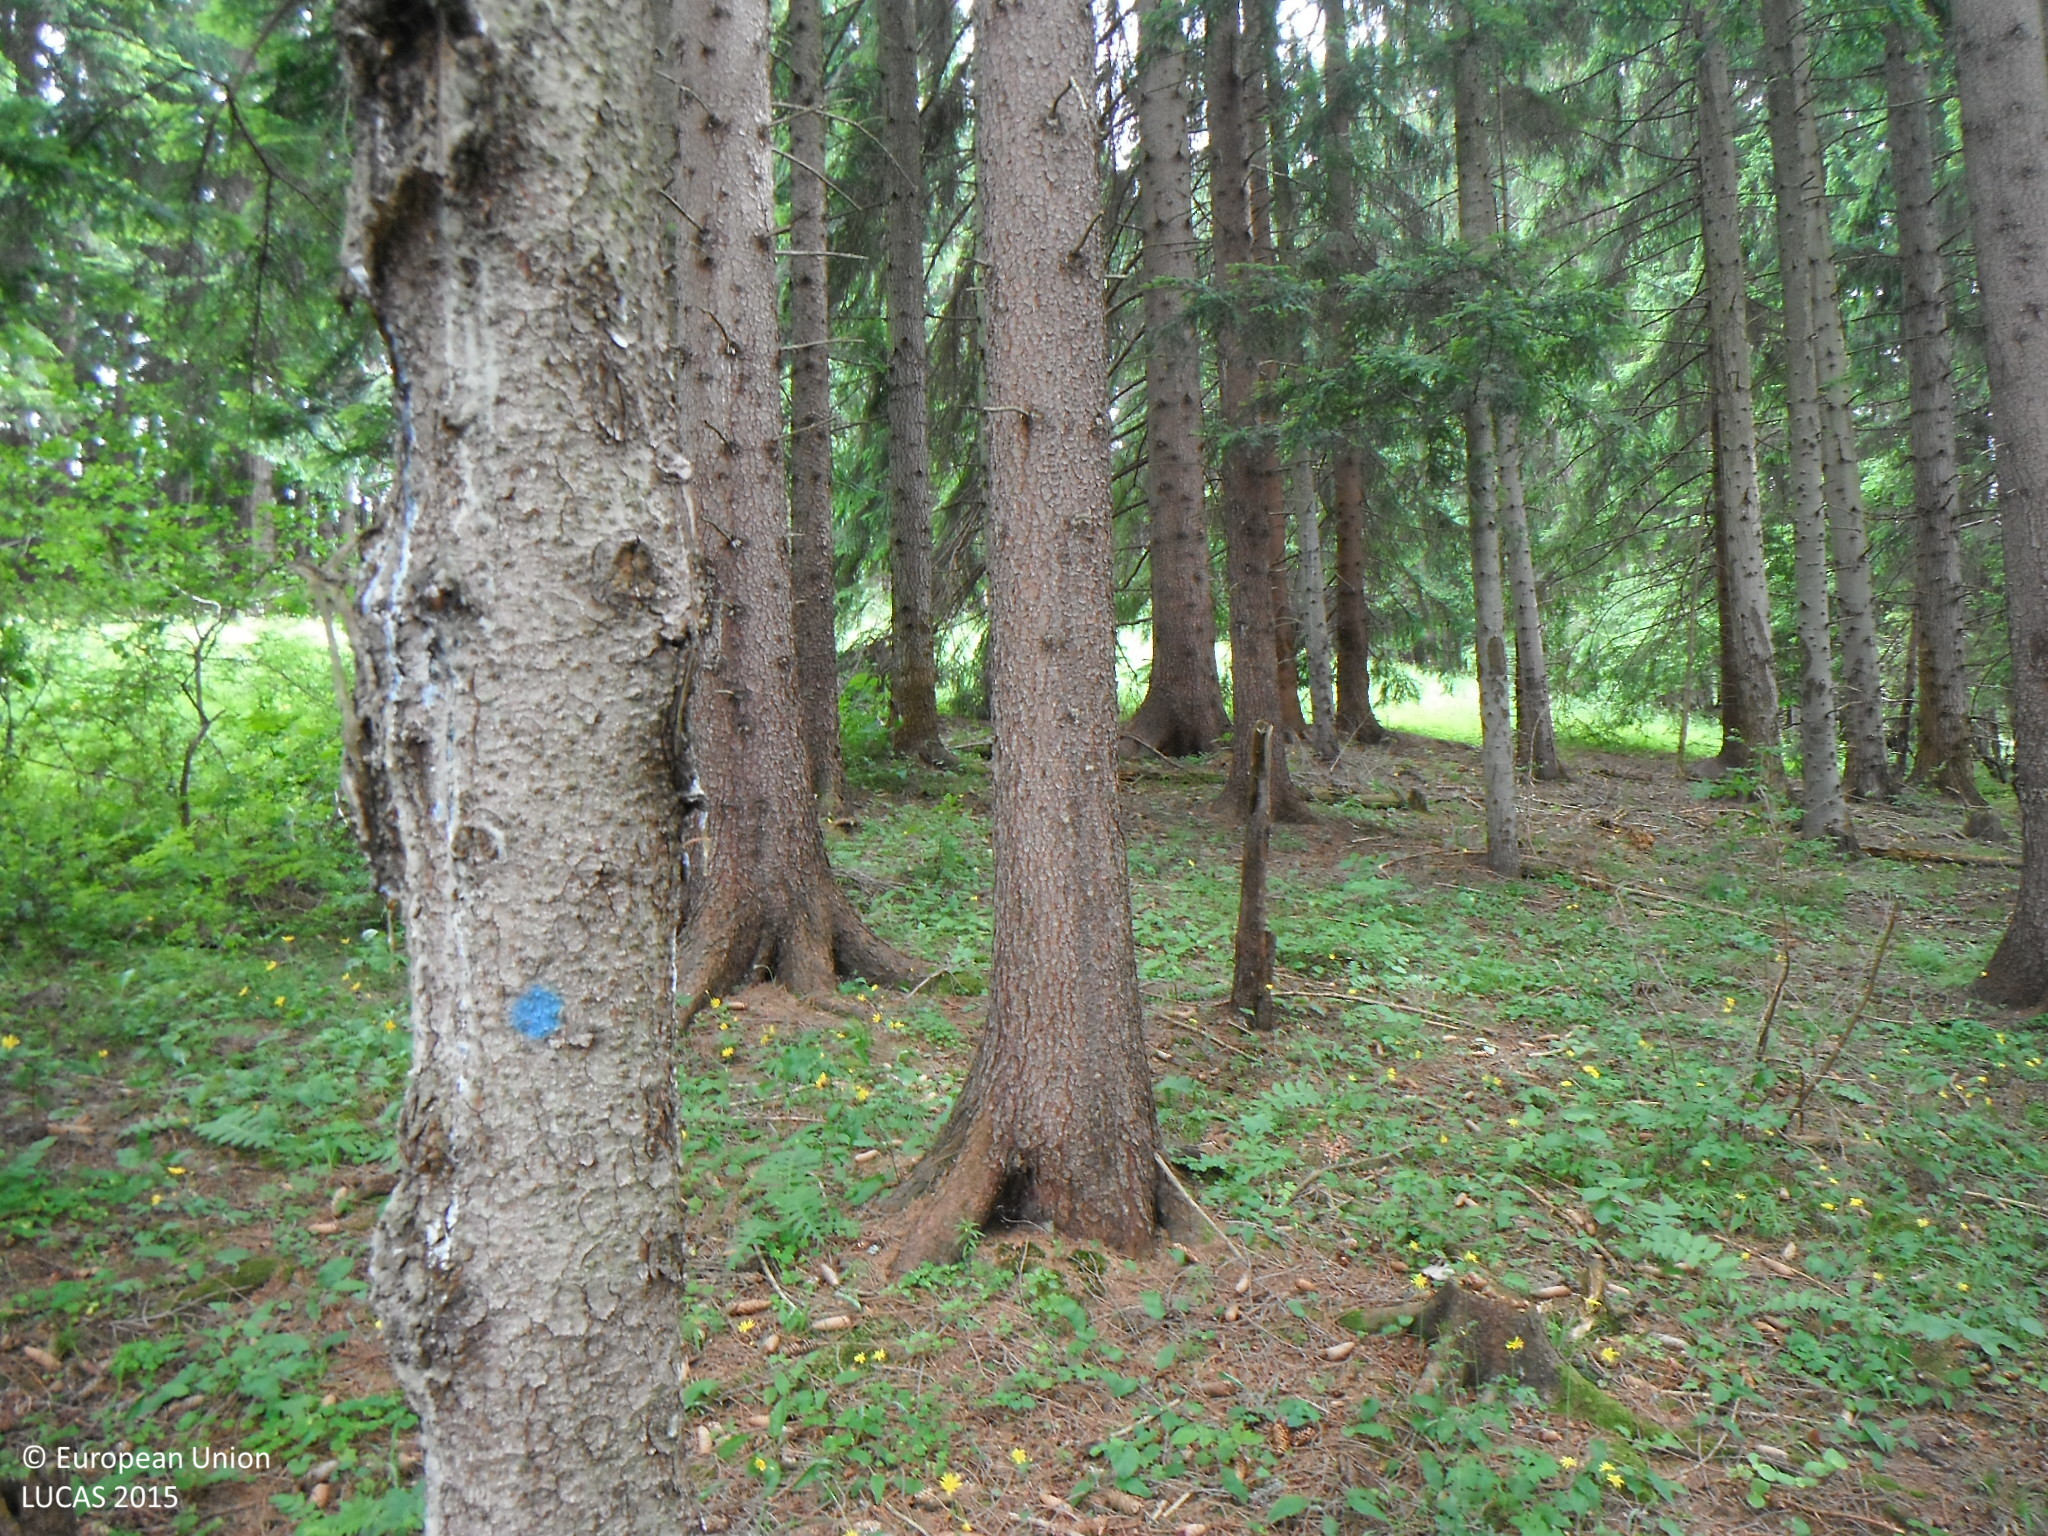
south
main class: Woodland
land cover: Spruce dominated coniferous woodland
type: alpine coniferous forest
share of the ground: > 75 %
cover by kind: coniferous forest trees 75 %, shrubs 10 %, herbaceous plants 10 %, lichens and mosses 5 %
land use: Forestry
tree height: > 5 m
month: June
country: SK
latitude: 49.0305
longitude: 19.4491
